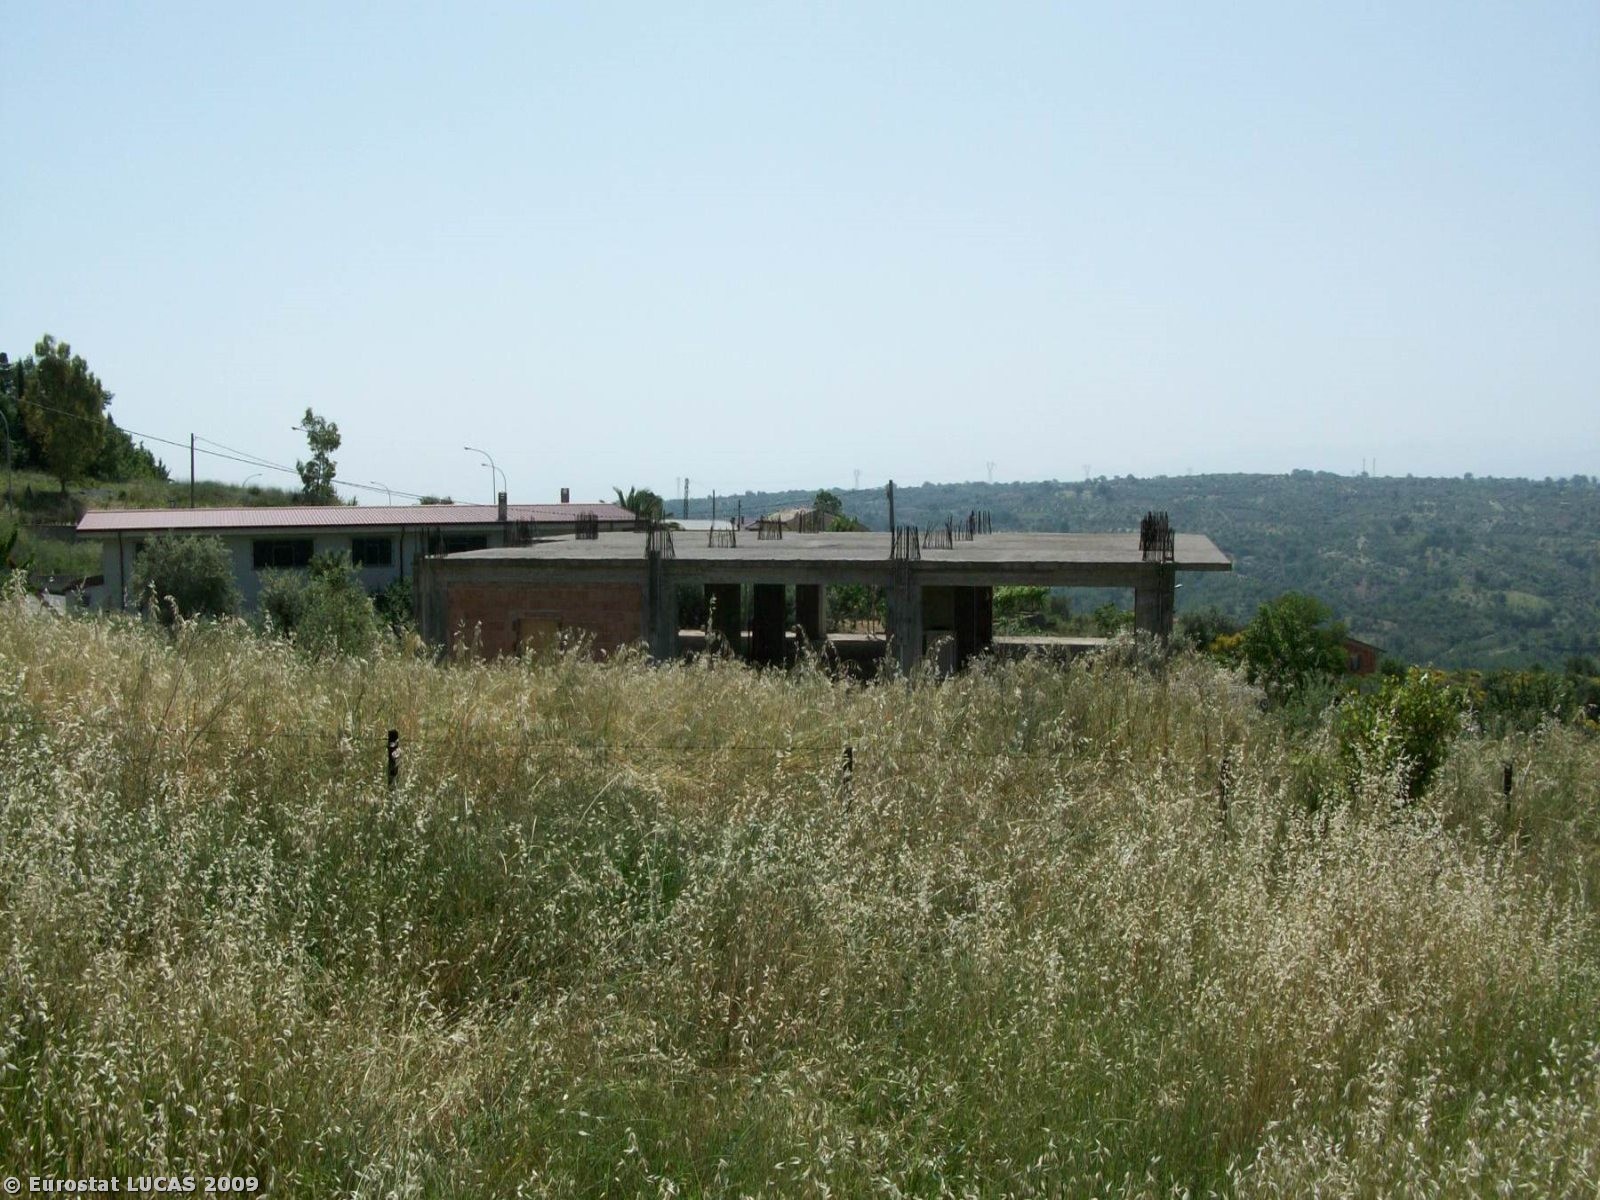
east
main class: Grassland
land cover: Spontaneously vegetated surfaces
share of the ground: > 75 %
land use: Fallow land
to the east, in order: Spontaneously vegetated surfaces; Fences; Spontaneously vegetated surfaces; Olive groves; Spontaneously vegetated surfaces; Electric lines; Paved roads, cycling and walking lanes; Other fruit trees and berries; Bare land; Artificial constructions in urban areas; Fences; Spontaneously vegetated surfaces; Grass margins; Paved roads, cycling and walking lanes; Grass margins; Artificial constructions in urban areas; Spontaneously vegetated surfaces; Grass margins; Paved roads, cycling and walking lanes
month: May
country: IT
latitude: 39.7644
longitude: 16.1708
